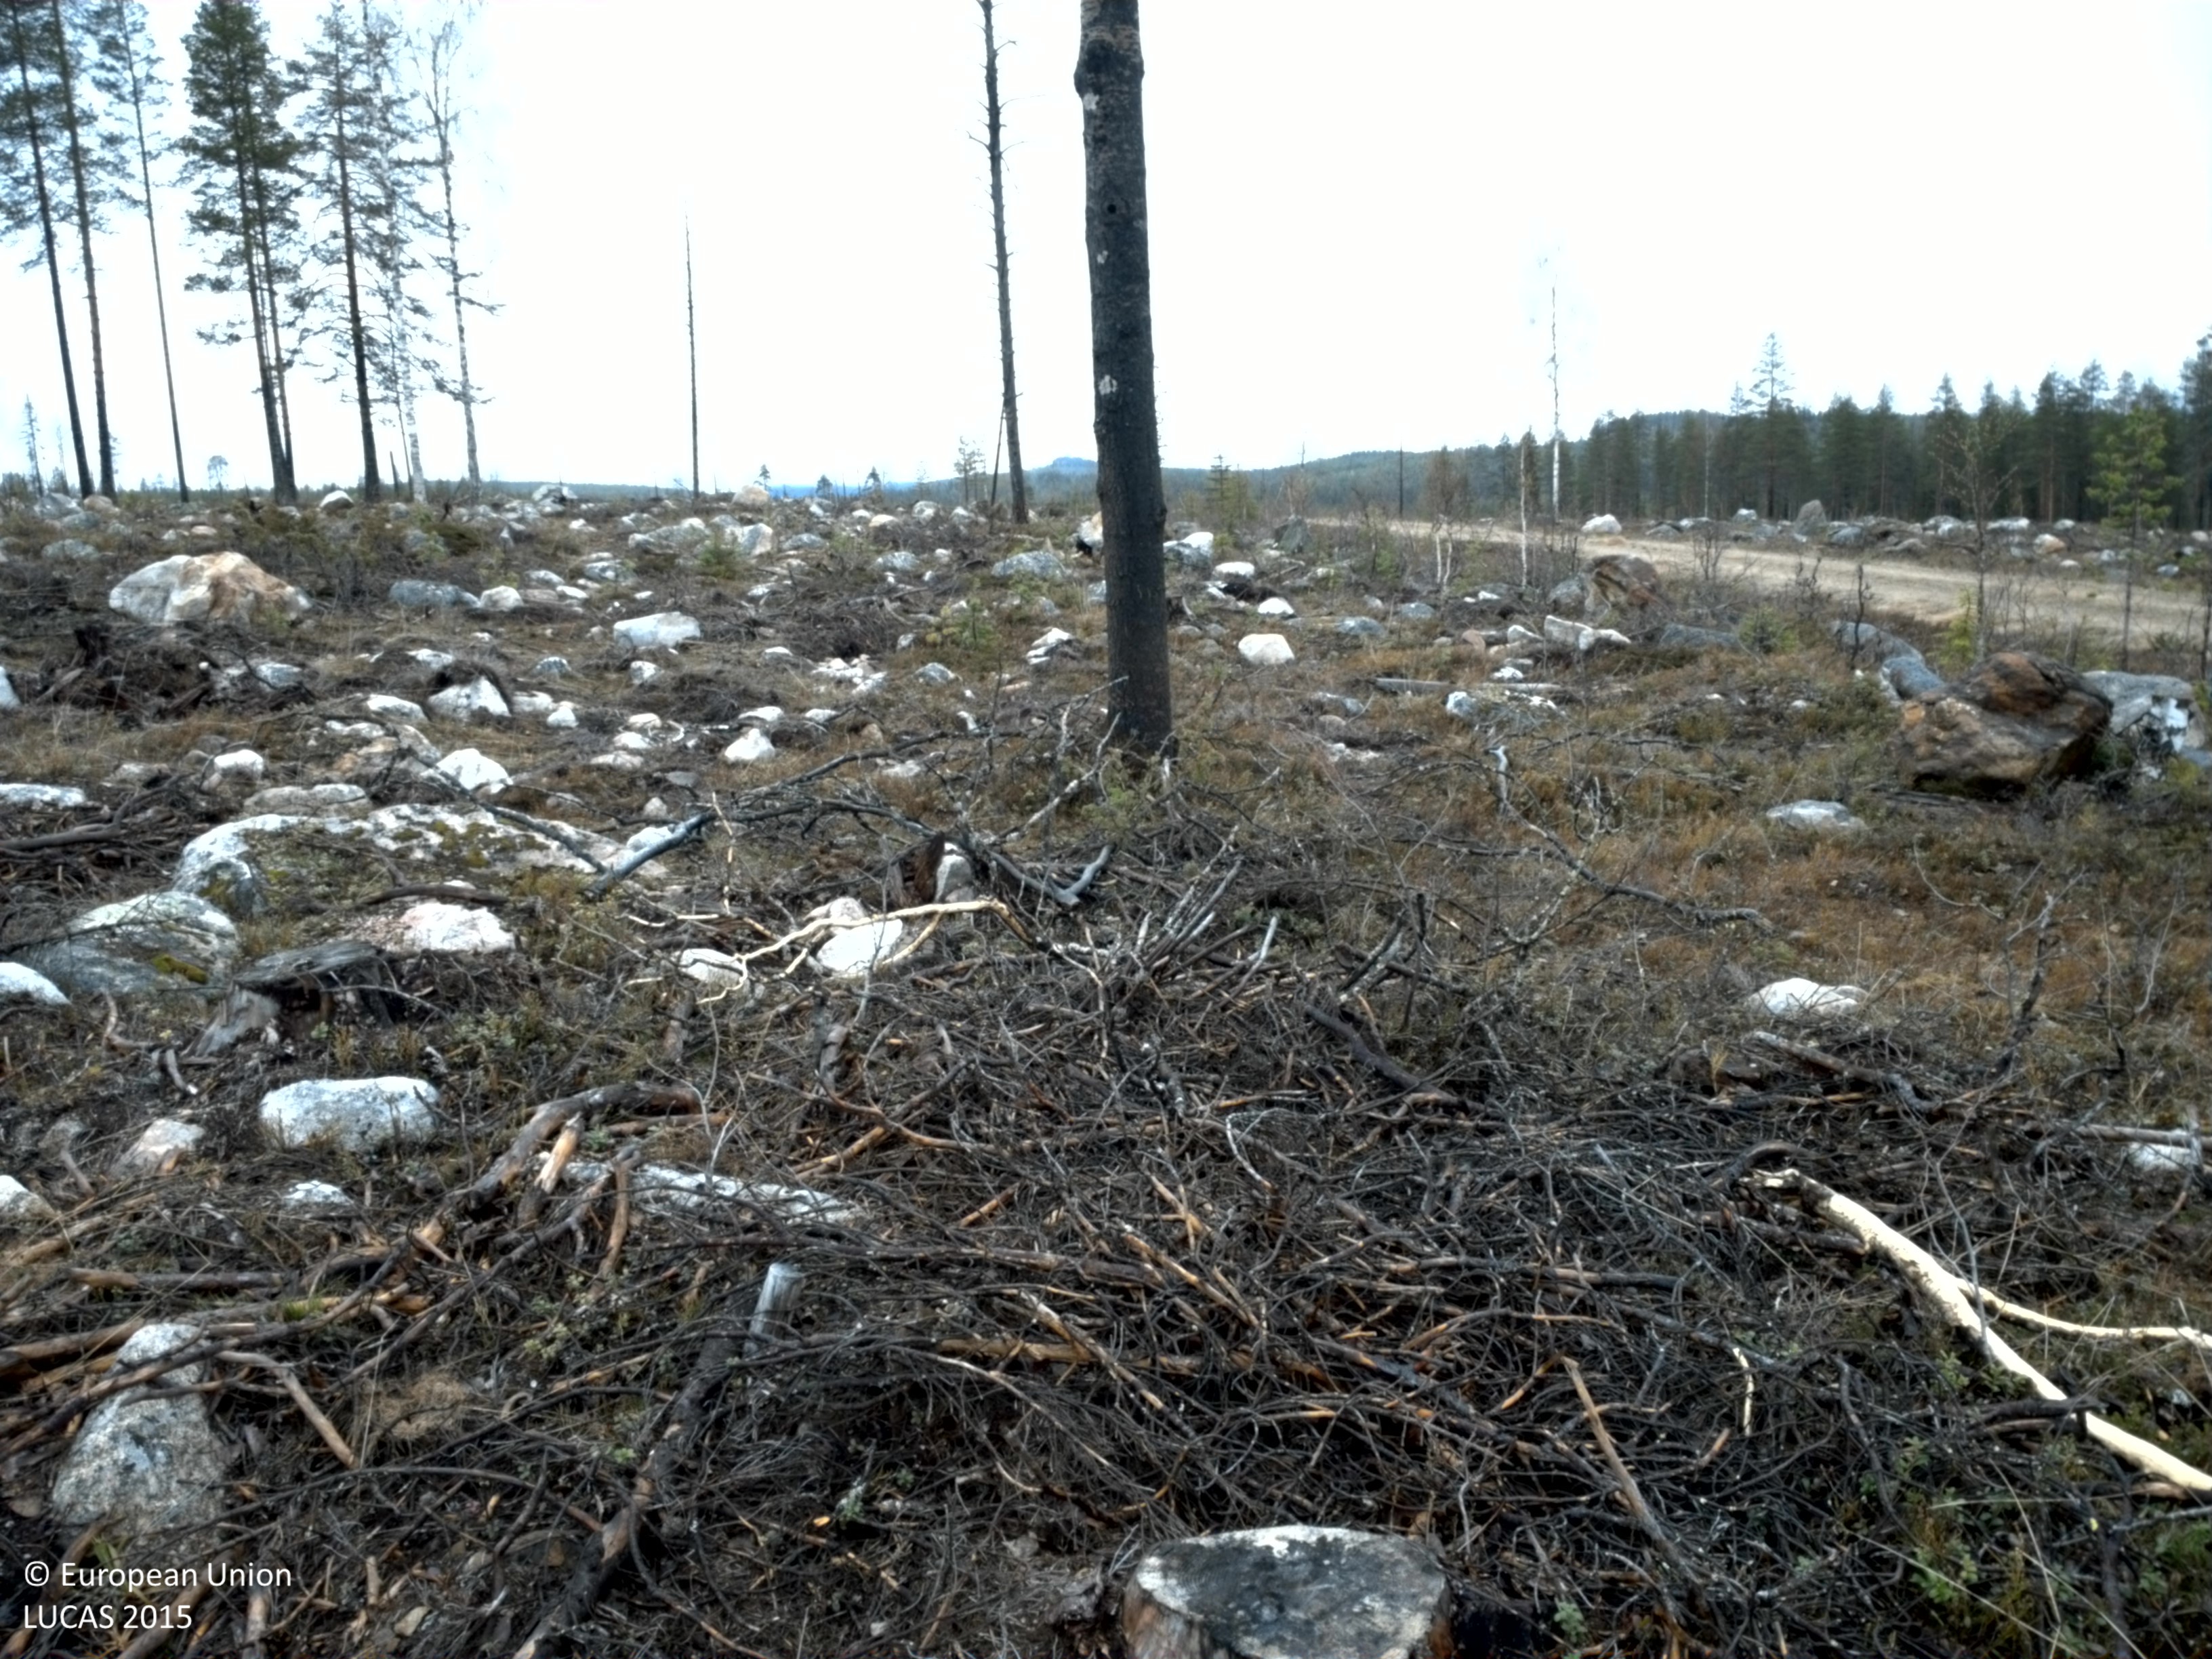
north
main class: Shrubland
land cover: Shrubland with sparse tree cover
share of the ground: > 75 %
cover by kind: shrubs 90 %, coniferous forest trees 5 %, consolidated bare surface 5 %
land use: Forestry
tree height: < 5 m
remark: Clear cut
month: May
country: SE
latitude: 66.2790
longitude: 23.3286
